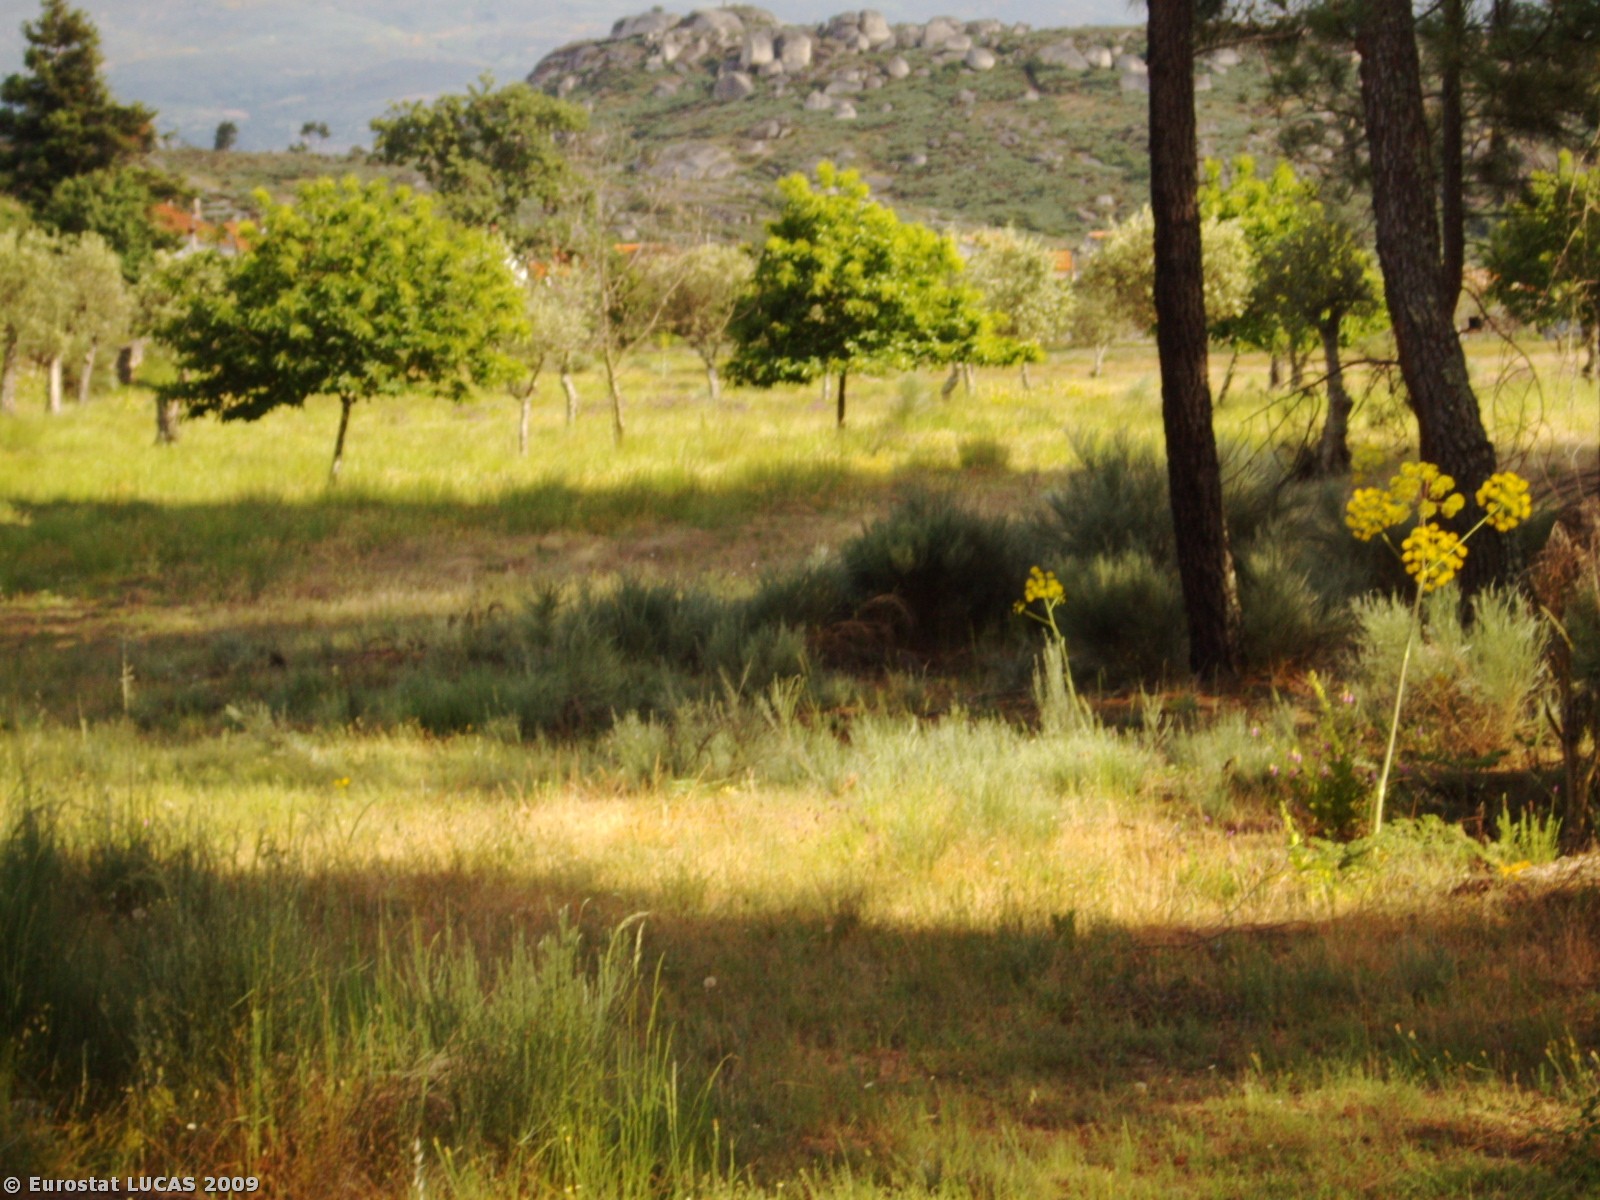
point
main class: Grassland
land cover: Spontaneously vegetated surfaces
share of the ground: > 75 %
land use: Fallow land
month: May
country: PT
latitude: 40.6575
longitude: -7.4879
